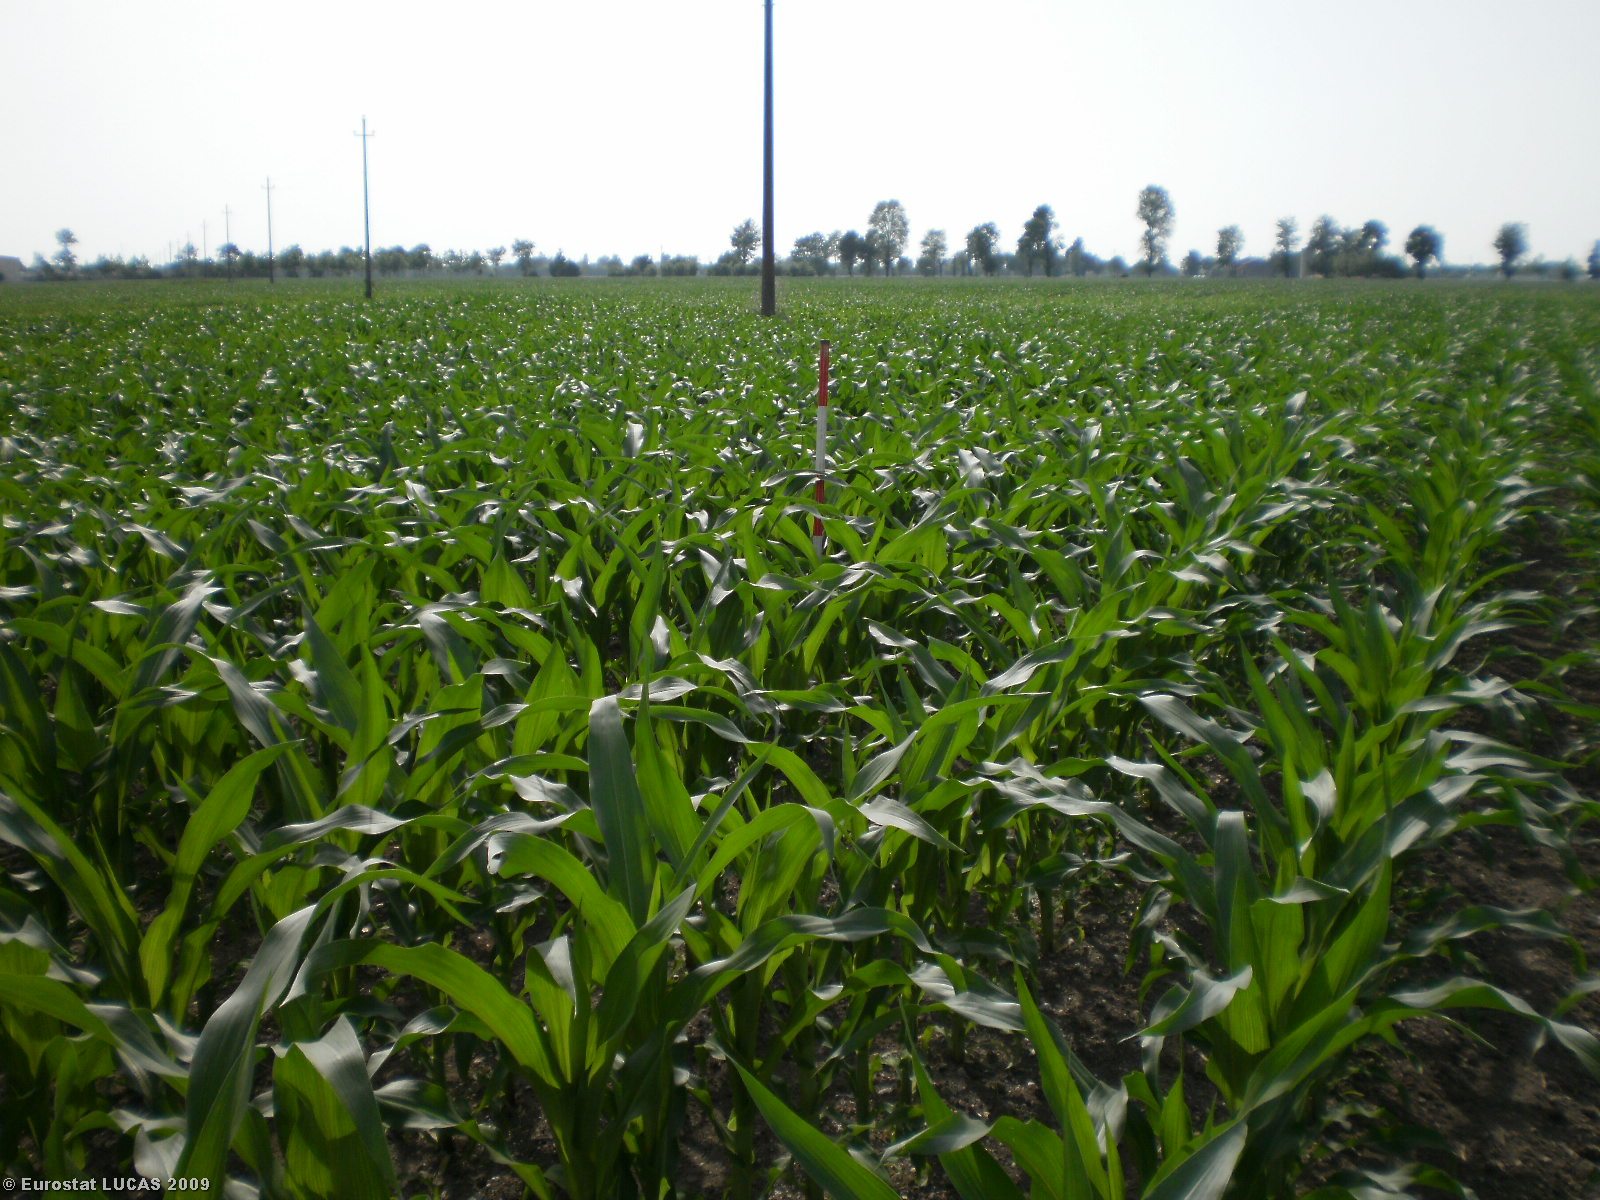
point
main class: Cropland
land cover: Maize
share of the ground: > 75 %
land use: Agriculture (excluding fallow land and kitchen gardens)
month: May
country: IT
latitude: 45.1771
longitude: 10.7748
